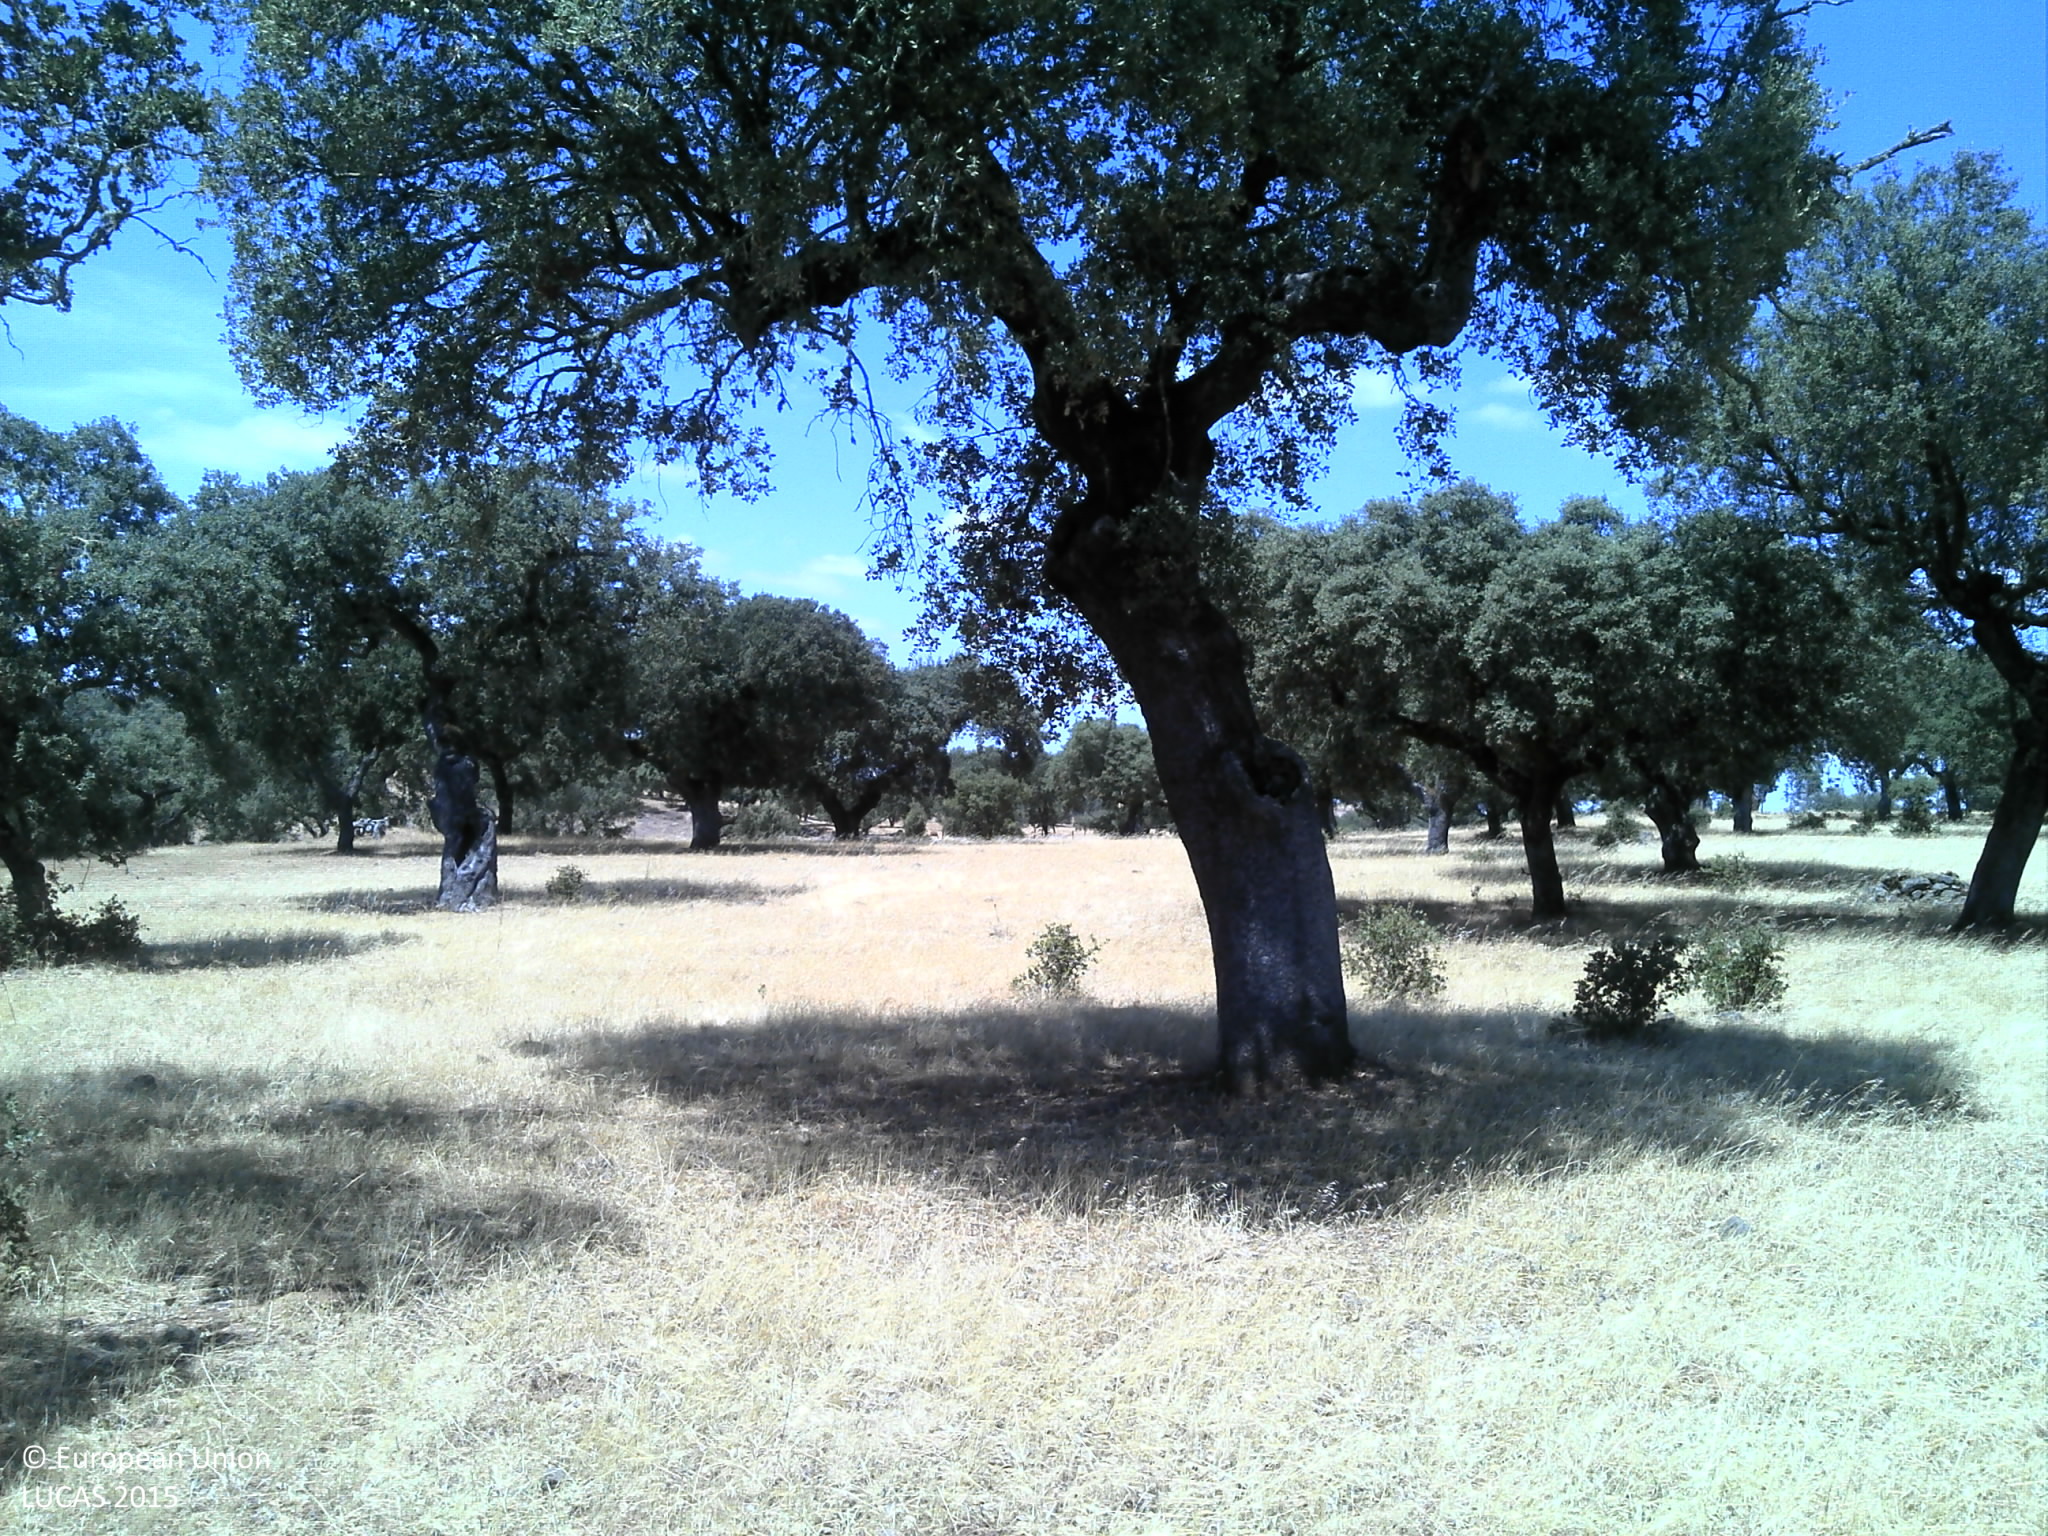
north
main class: Woodland
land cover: Broadleaved woodland
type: broadleaved evergreen forest
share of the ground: 25 - 50 %
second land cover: Grassland without tree/shrub cover
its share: 50 - 75 %
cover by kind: herbaceous plants 65 %, broadleaved forest trees 25 %, unconsolidated bare surface 10 %
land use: Forestry
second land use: Agriculture (excluding fallow land and kitchen gardens)
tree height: > 5 m
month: July
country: PT
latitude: 38.8204
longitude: -7.3418
